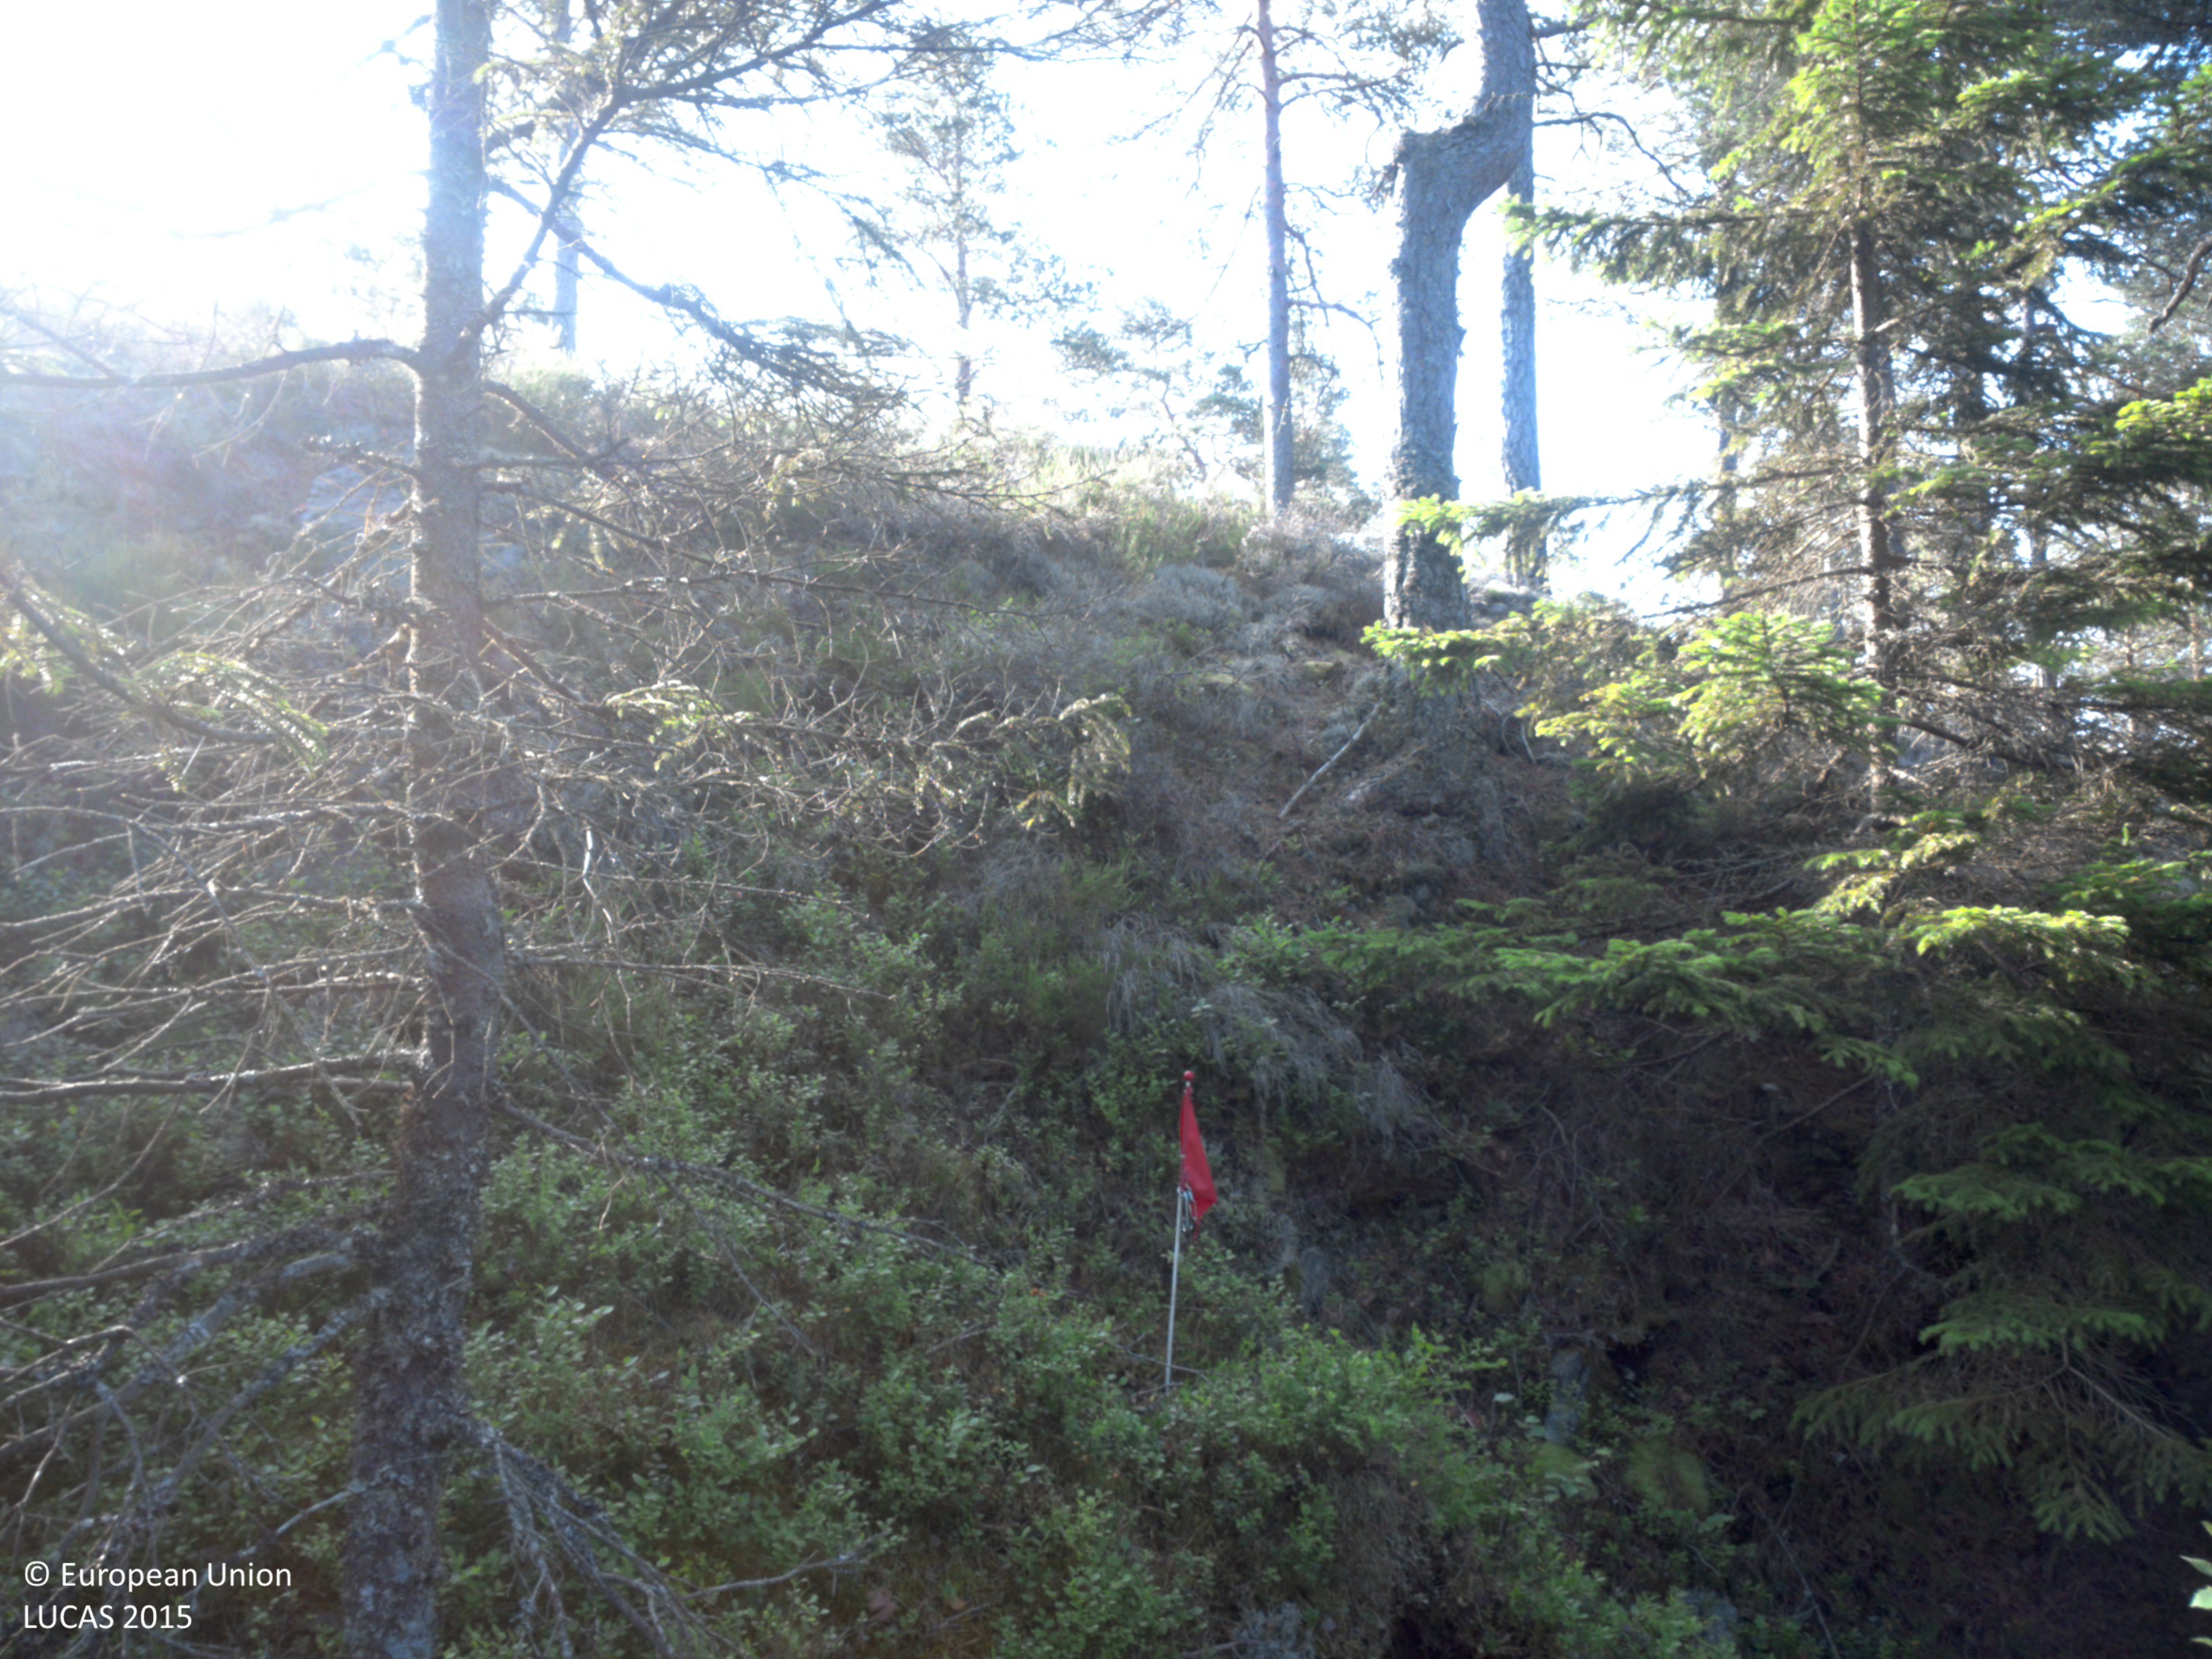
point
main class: Woodland
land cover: Pine dominated coniferous woodland
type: boreal forest
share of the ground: 25 - 50 %
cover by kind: coniferous forest trees 40 %, shrubs 30 %, lichens and mosses 30 %
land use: Forestry
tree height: > 5 m
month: July
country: SE
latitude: 58.8370
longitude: 11.8150
